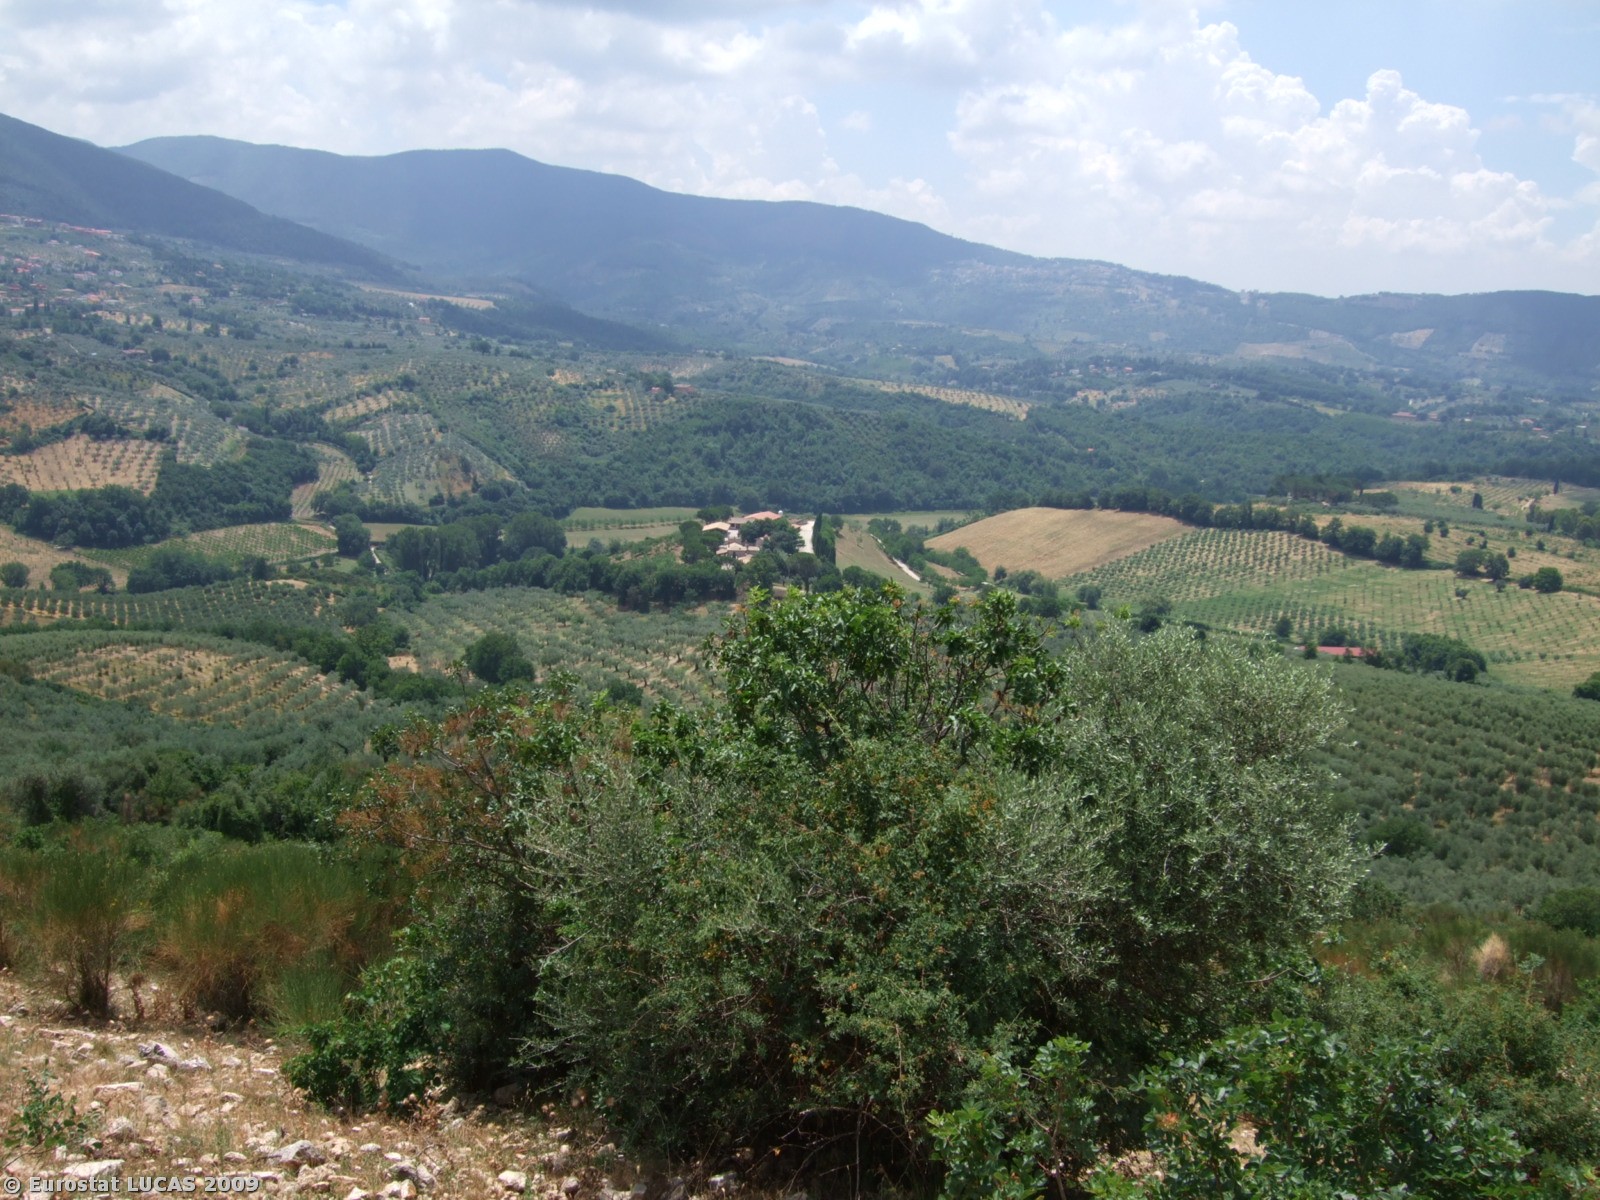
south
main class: Shrubland
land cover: Shrubland without tree cover
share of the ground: > 75 %
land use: Unused
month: June
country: IT
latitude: 42.1806
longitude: 12.8353
